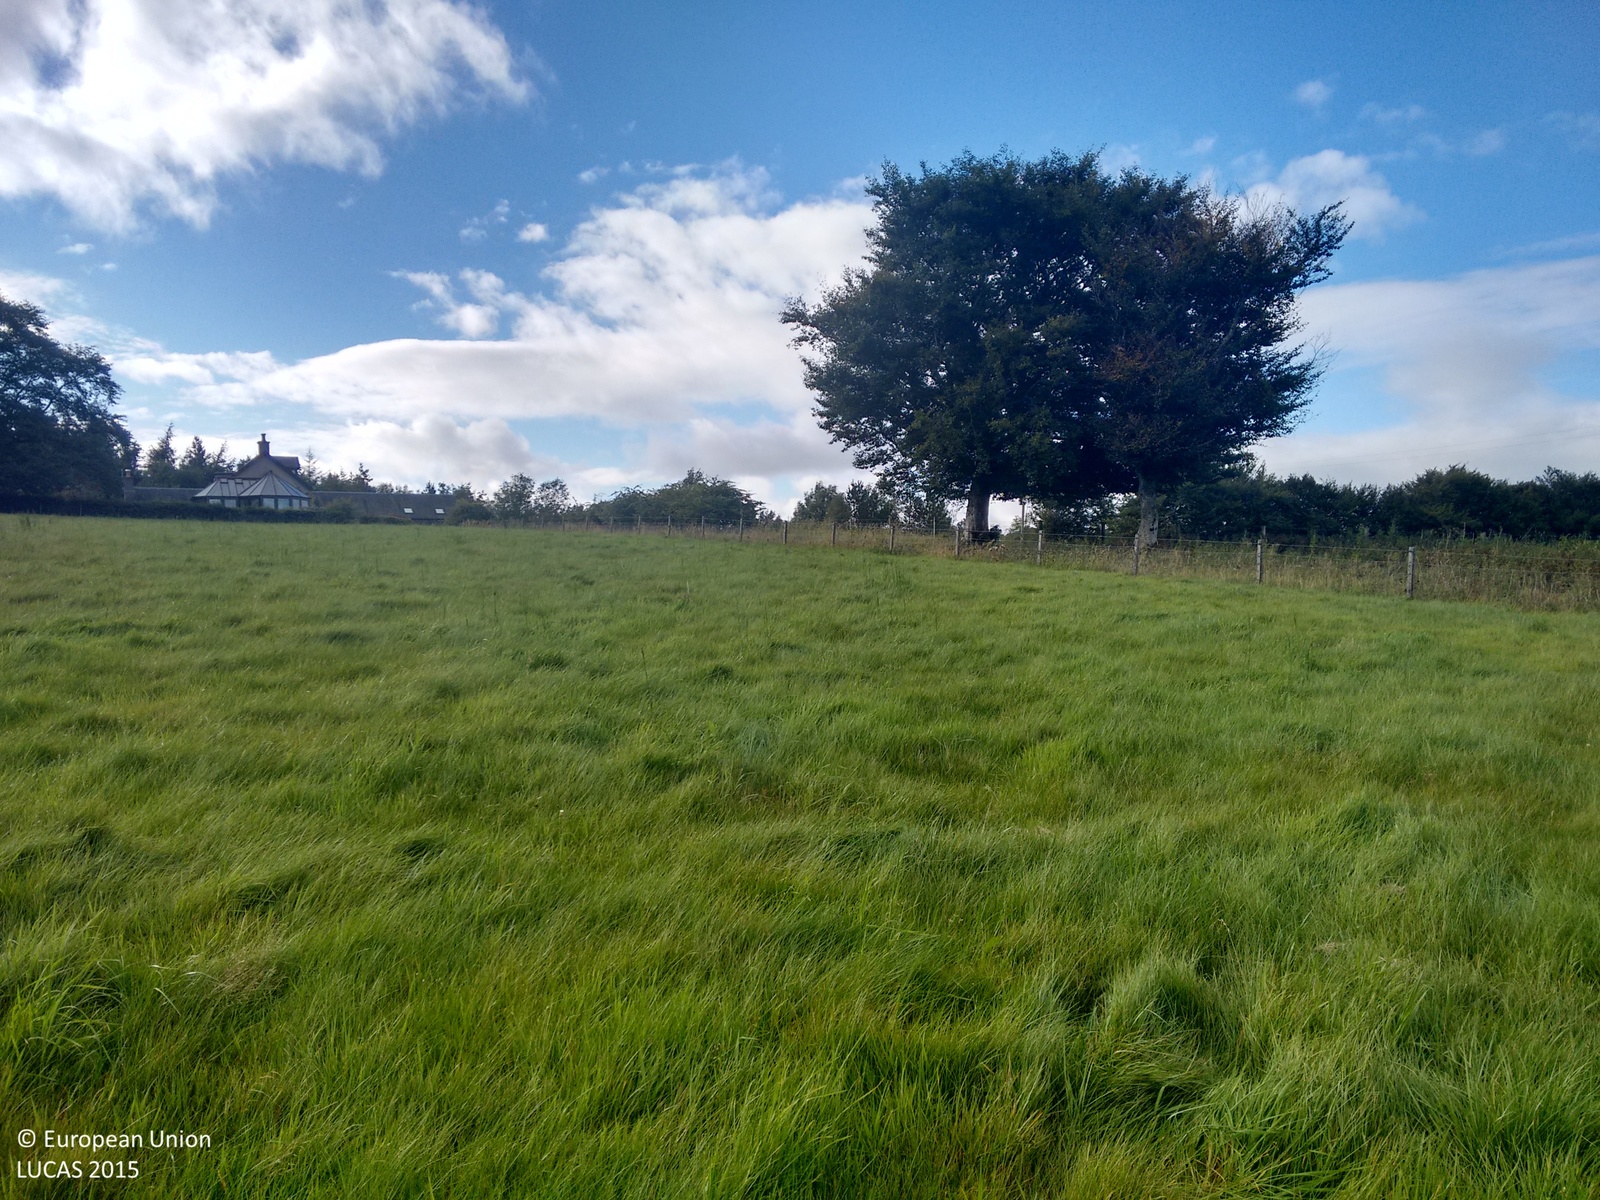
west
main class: Grassland
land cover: Grassland without tree/shrub cover
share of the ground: > 75 %
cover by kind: herbaceous plants 100 %
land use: Agriculture (excluding fallow land and kitchen gardens)
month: September
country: GB
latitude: 55.5712
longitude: -3.5766
